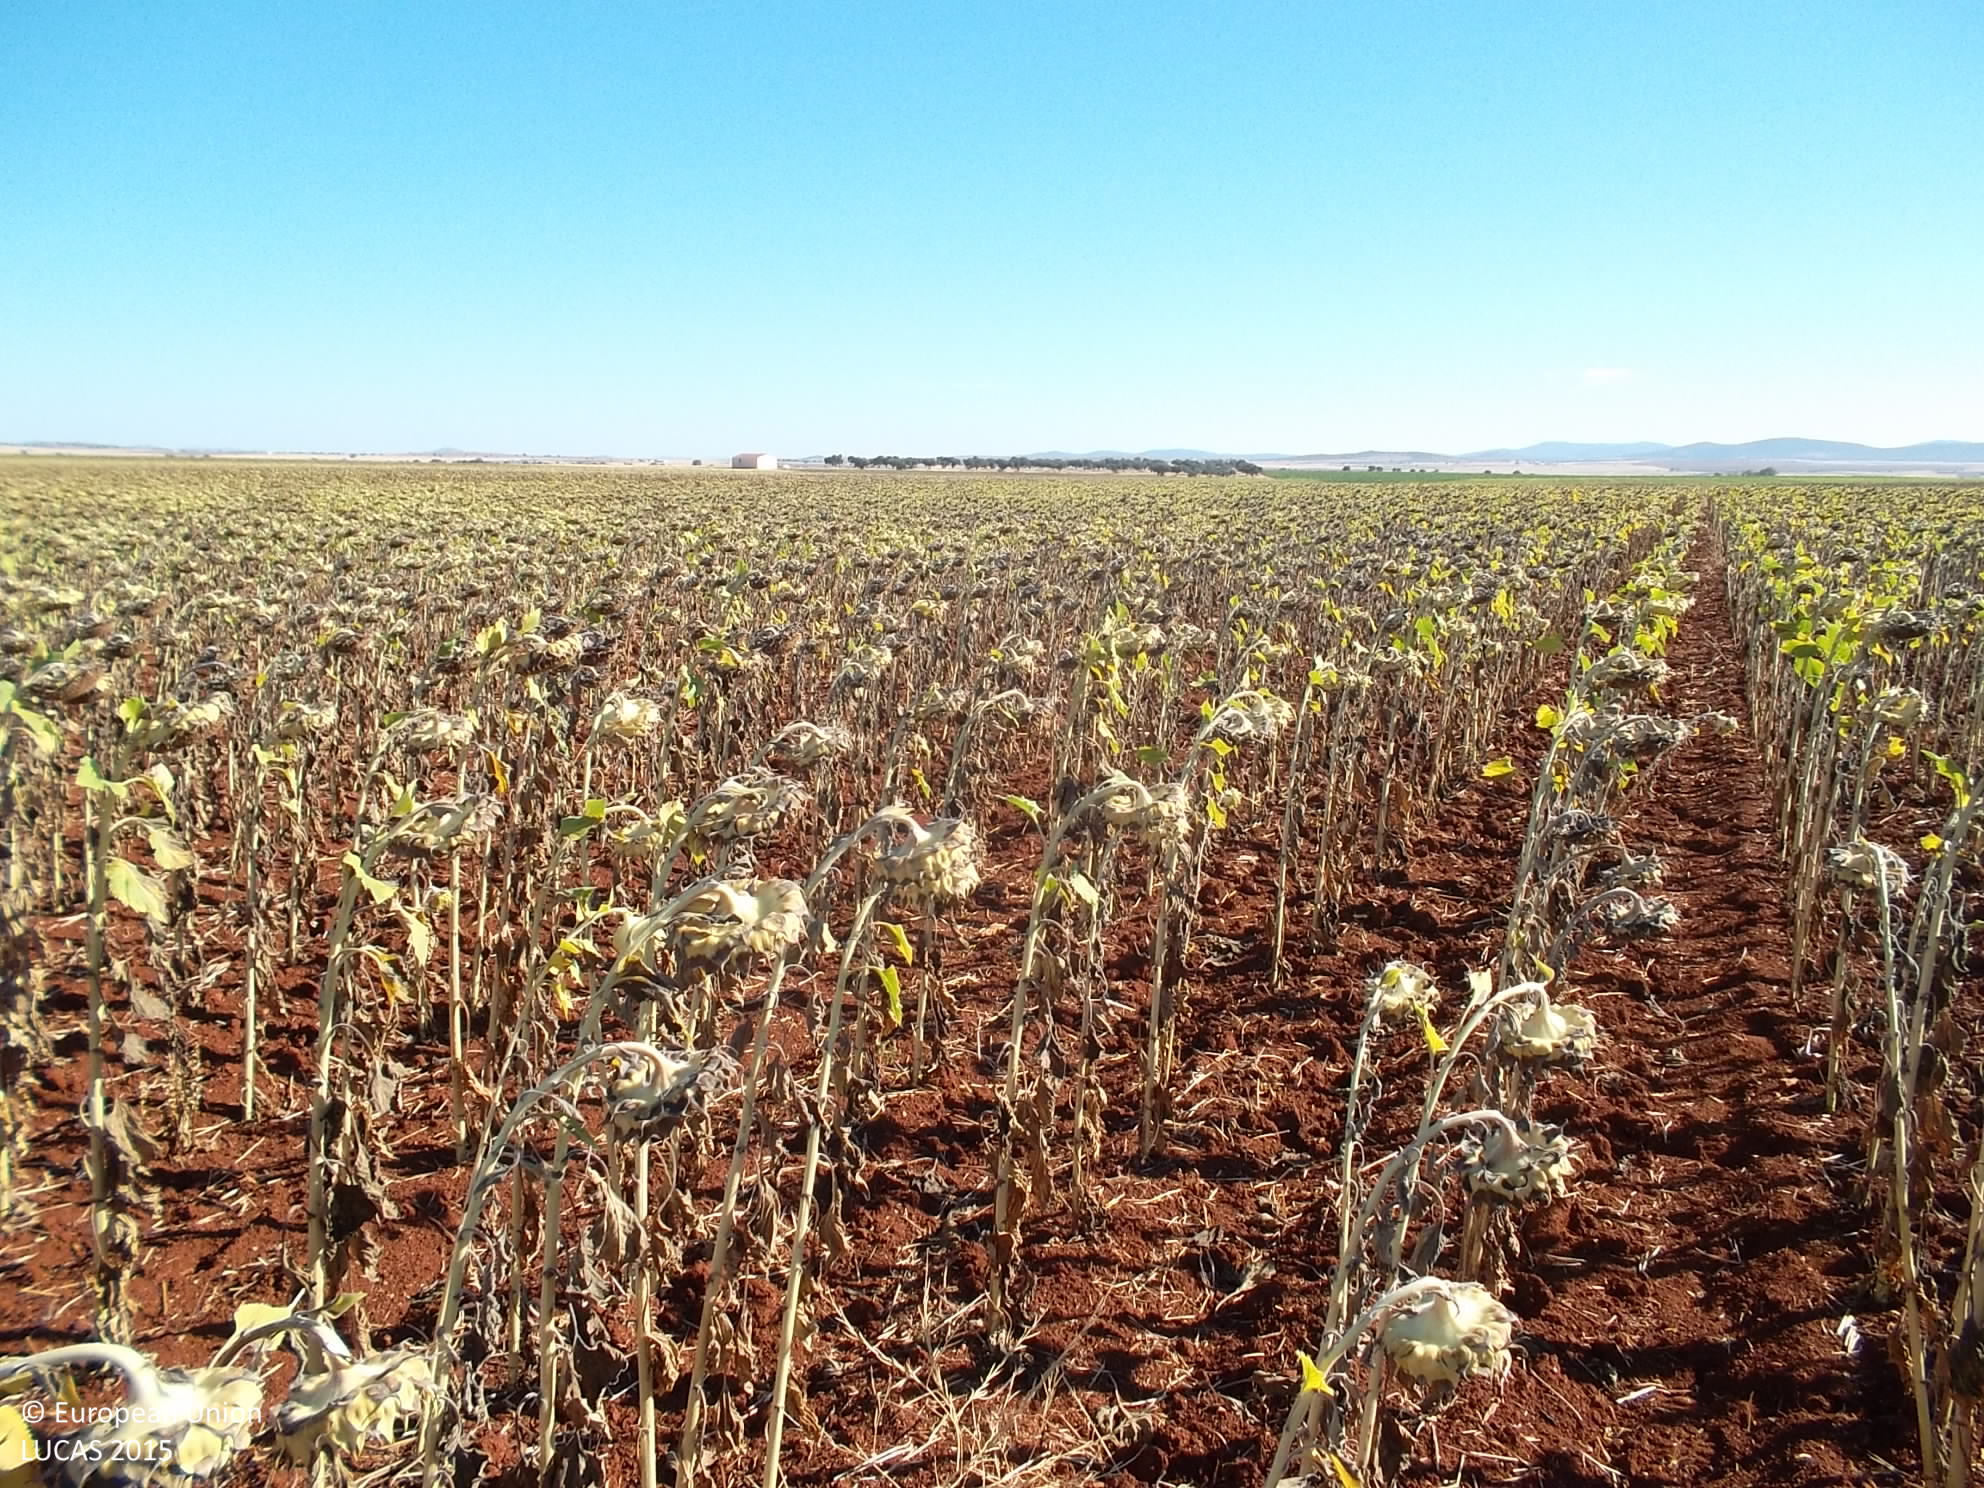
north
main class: Cropland
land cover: Sunflower
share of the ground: > 75 %
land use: Agriculture (excluding fallow land and kitchen gardens)
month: July
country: ES
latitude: 38.3744
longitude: -5.7769
